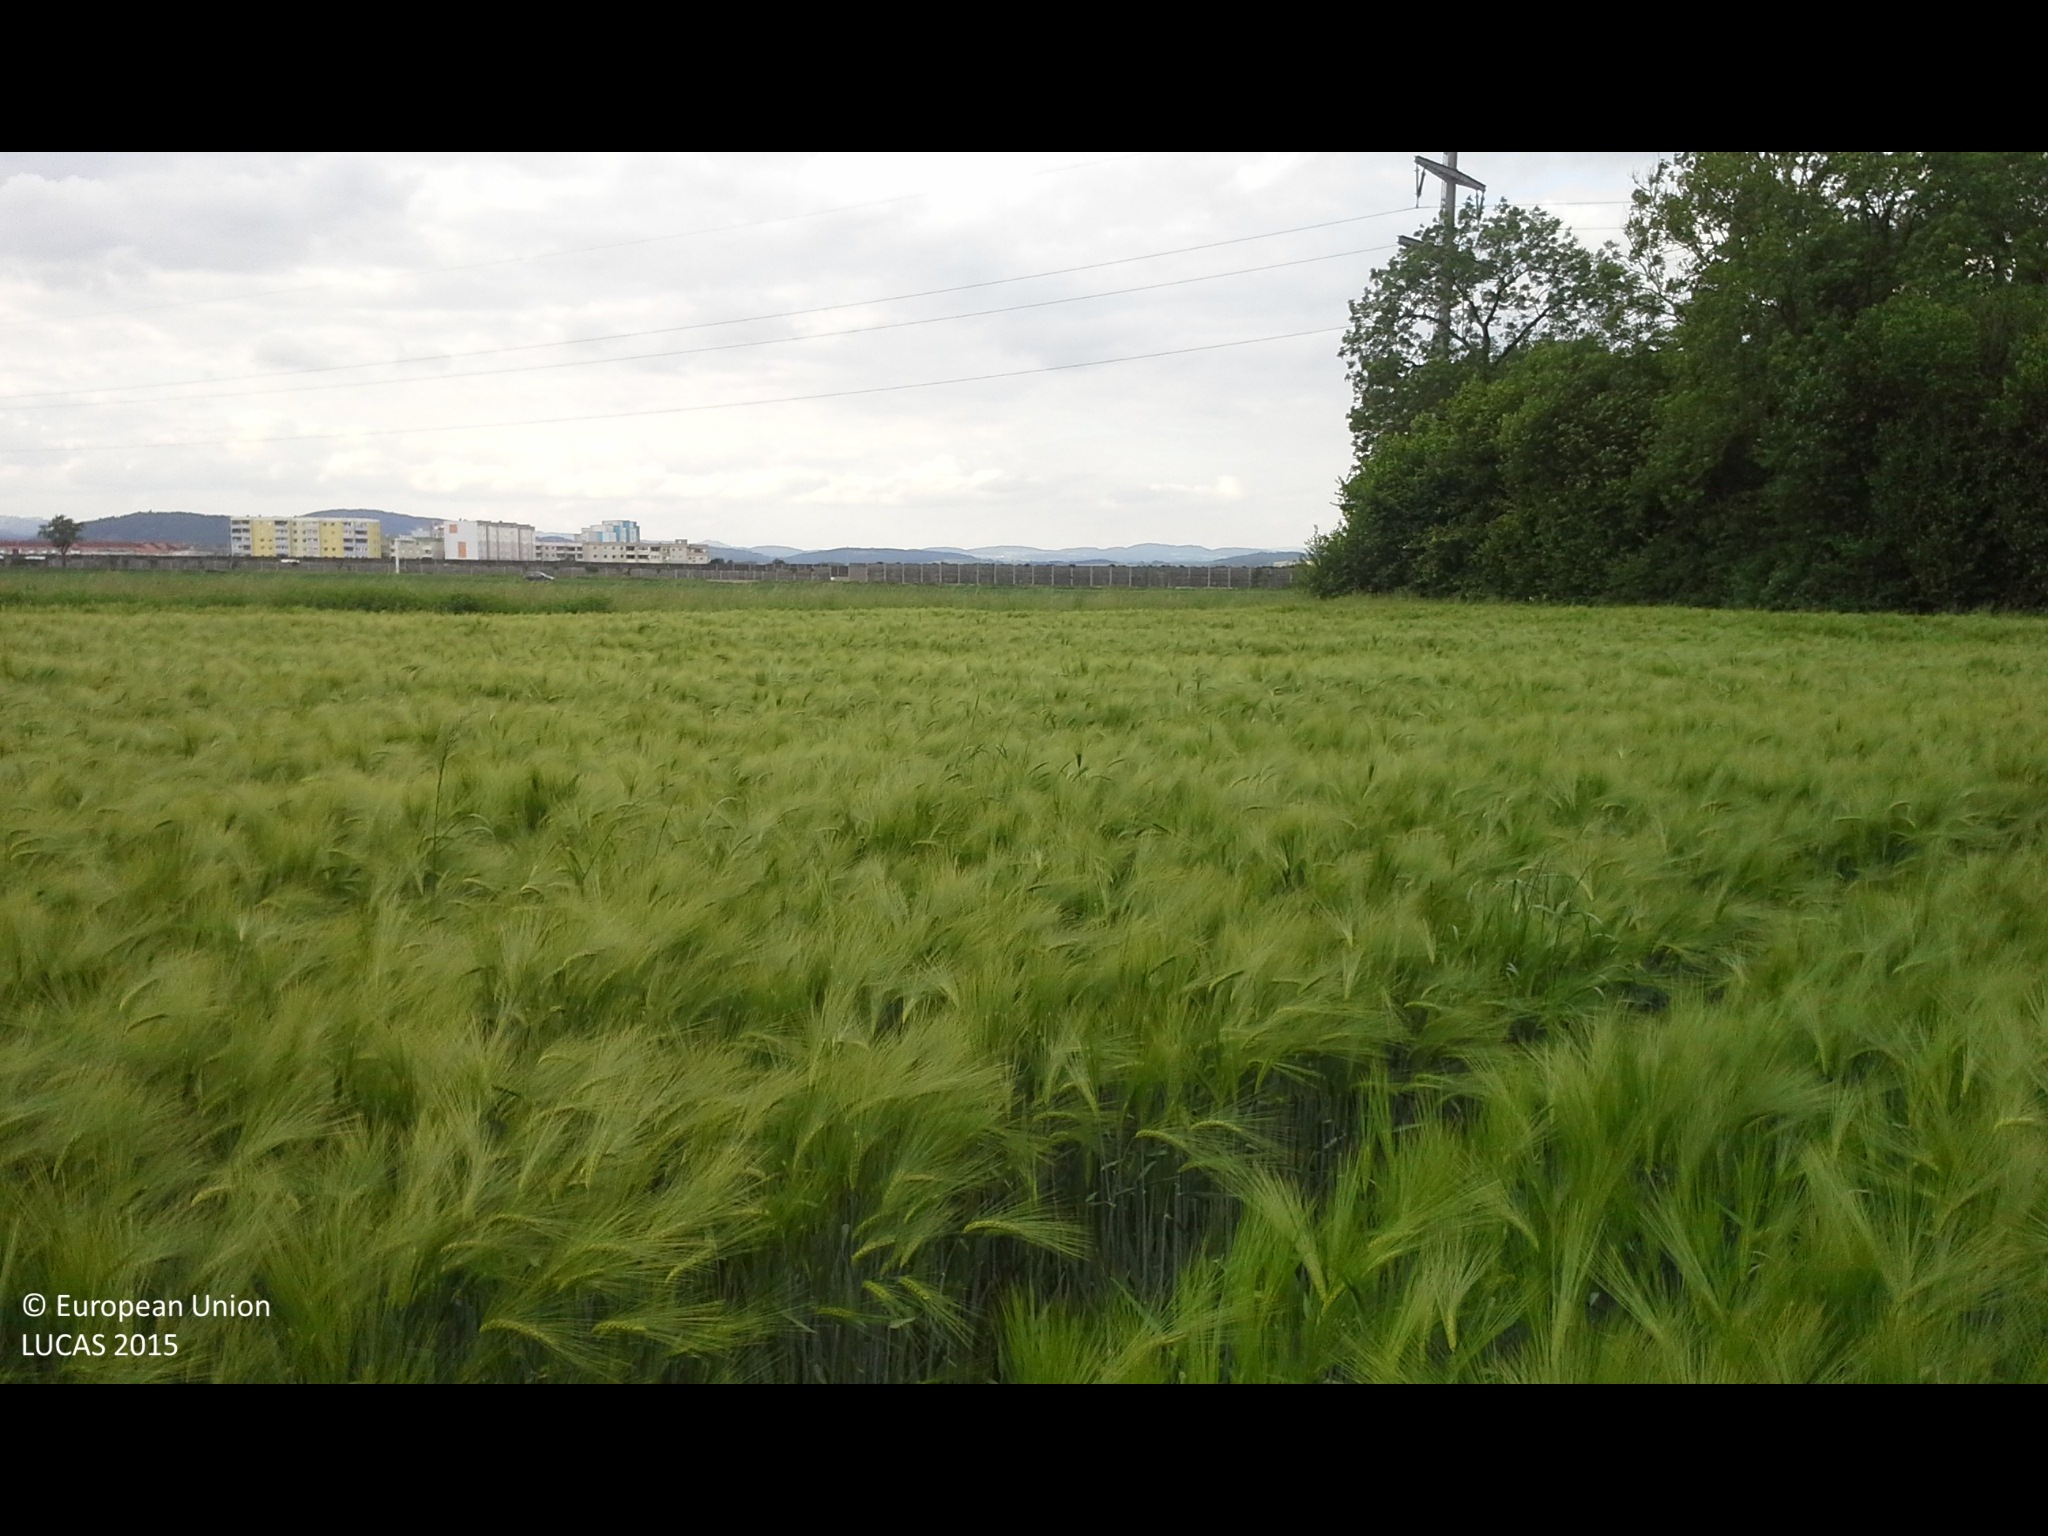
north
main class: Cropland
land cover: Barley
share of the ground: > 75 %
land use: Agriculture (excluding fallow land and kitchen gardens)
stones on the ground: < 10 %
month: May
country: AT
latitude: 48.2067
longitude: 14.4273
